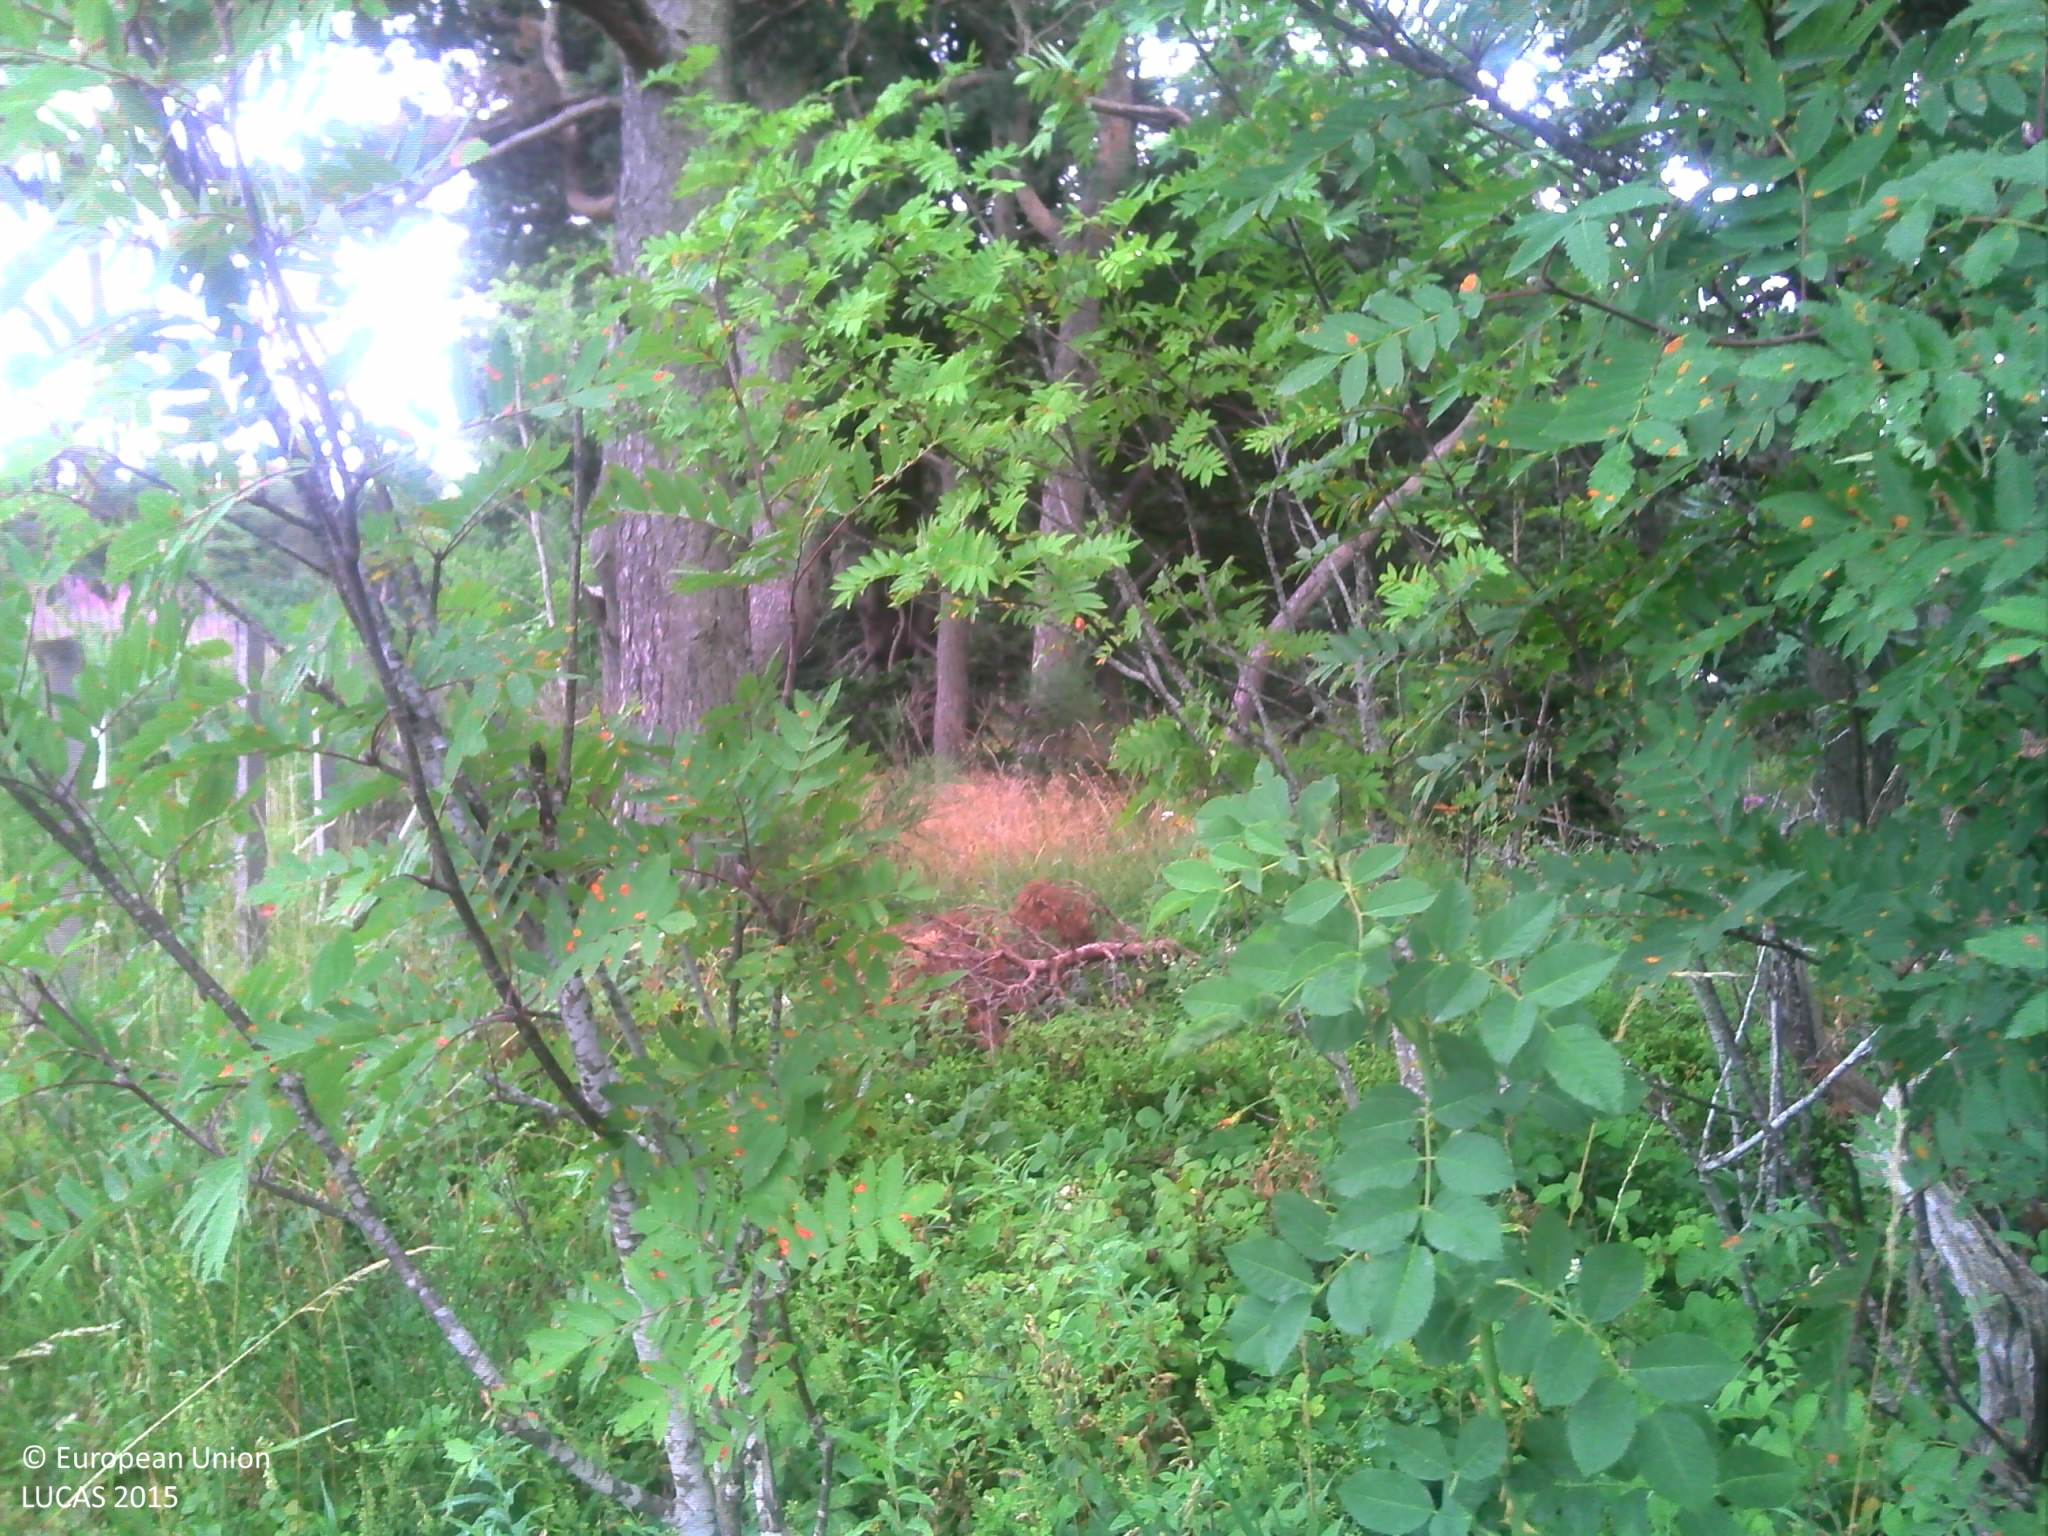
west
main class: Woodland
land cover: Pine dominated mixed woodland
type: mesophytic deciduous forest
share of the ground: > 75 %
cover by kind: broadleaved forest trees 45 %, coniferous forest trees 35 %, shrubs 10 %, herbaceous plants 10 %
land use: Forestry
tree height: < 5 m
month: August
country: FR
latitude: 45.0366
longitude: 4.1781
